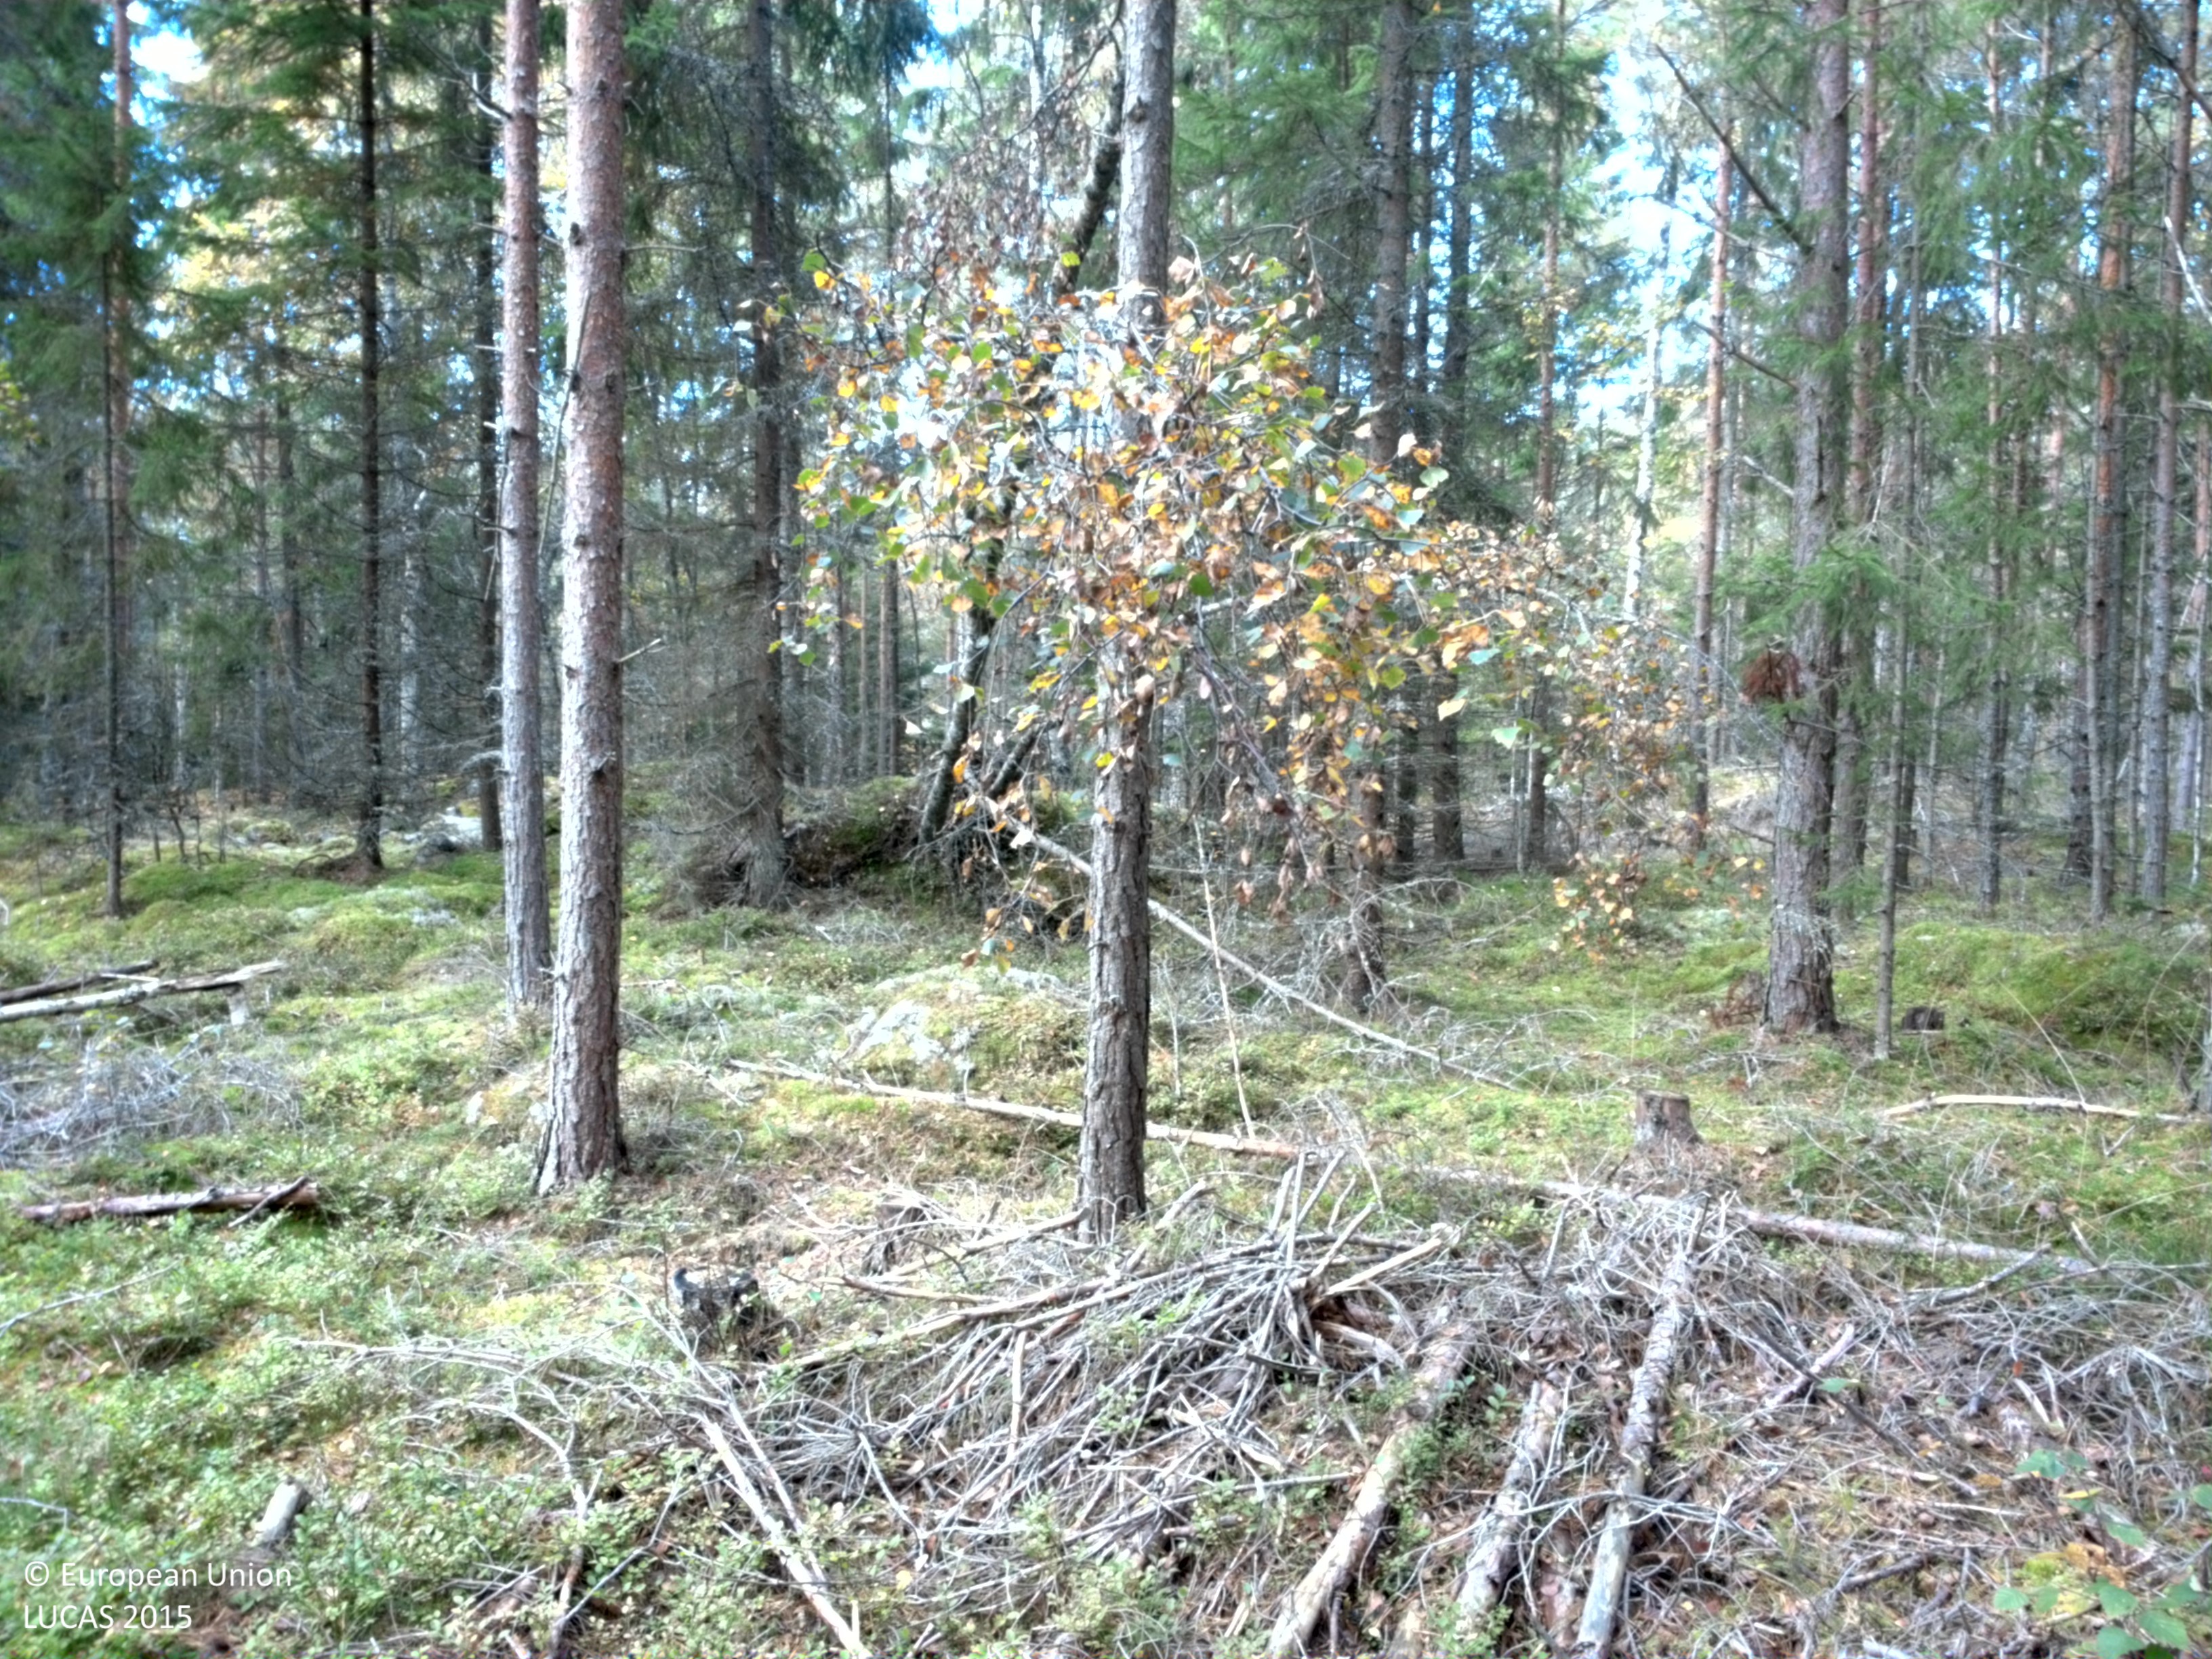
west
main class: Woodland
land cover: Pine dominated mixed woodland
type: boreal forest
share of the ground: 10 - 25 %
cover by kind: shrubs 40 %, lichens and mosses 35 %, coniferous forest trees 15 %, broadleaved forest trees 10 %
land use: Forestry
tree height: > 5 m
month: September
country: SE
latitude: 59.2028
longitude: 14.0719
